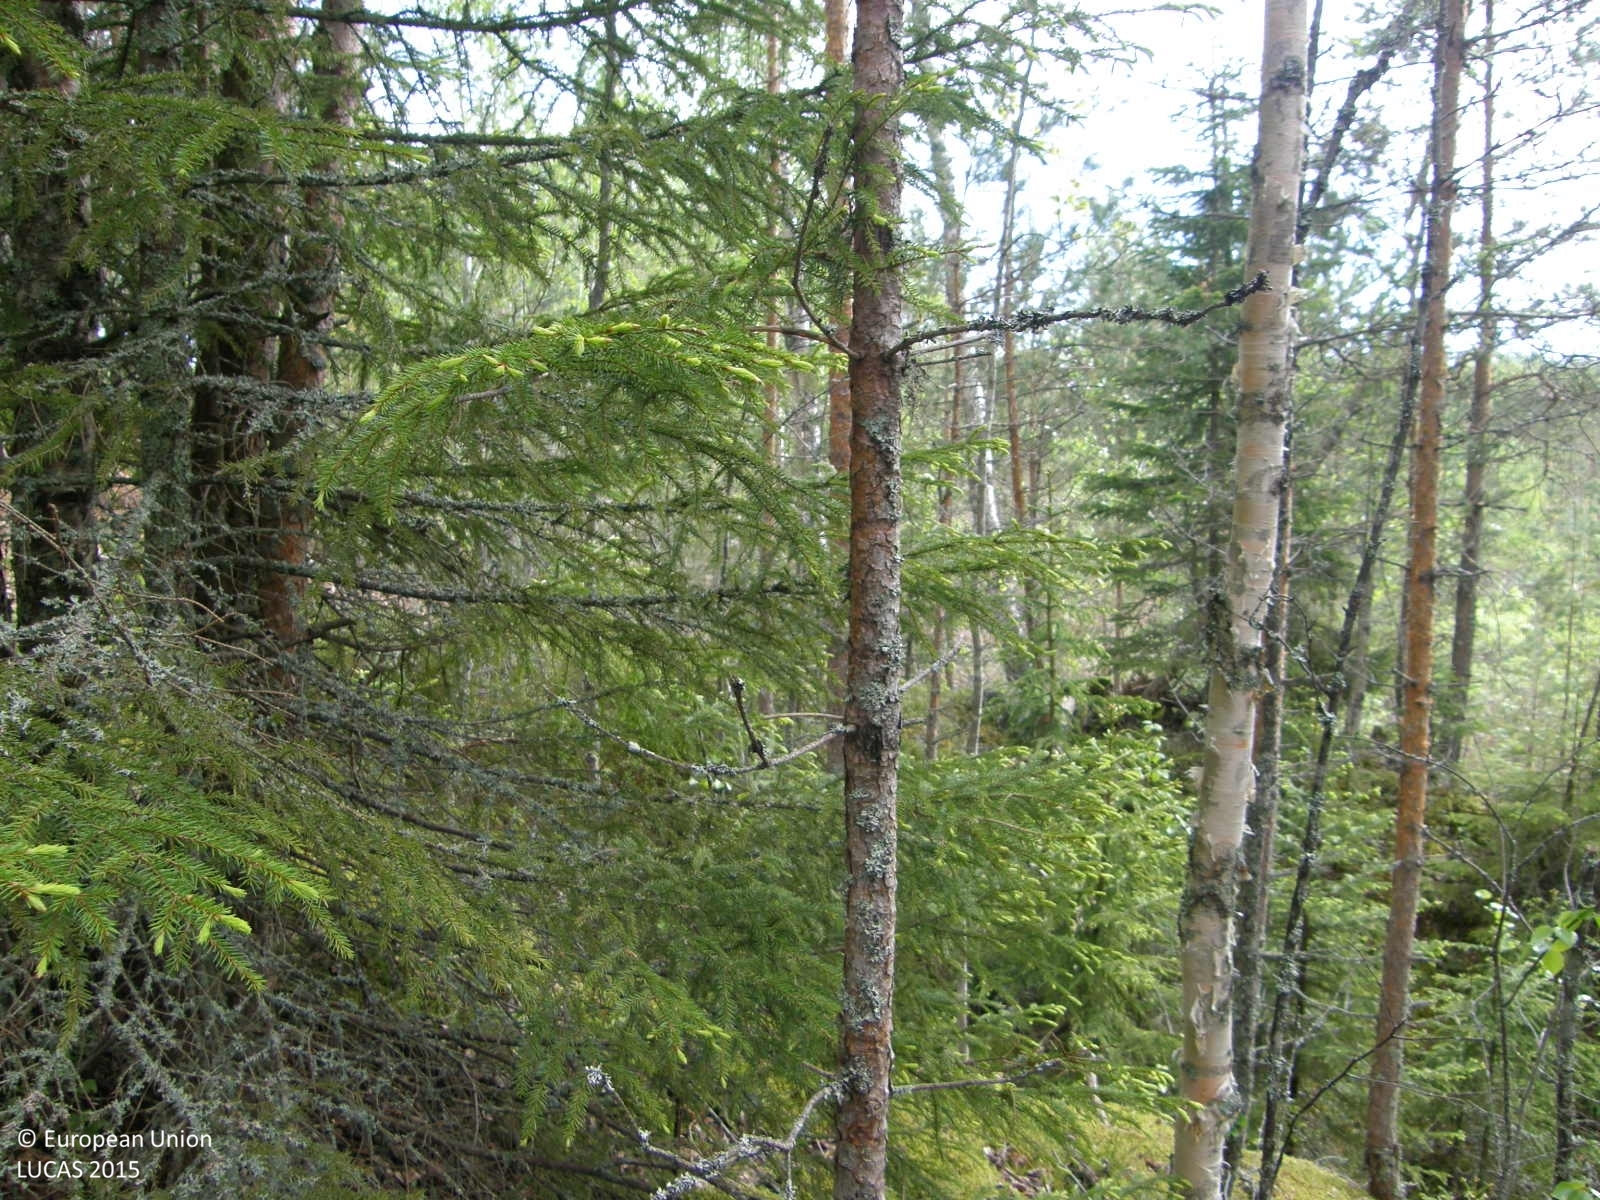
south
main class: Woodland
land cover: Pine dominated mixed woodland
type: boreal forest
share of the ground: > 75 %
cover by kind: coniferous forest trees 65 %, broadleaved forest trees 25 %, consolidated bare surface 5 %, unconsolidated bare surface 5 %
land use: Forestry
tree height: > 5 m
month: June
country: FI
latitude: 61.9391
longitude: 21.6542
